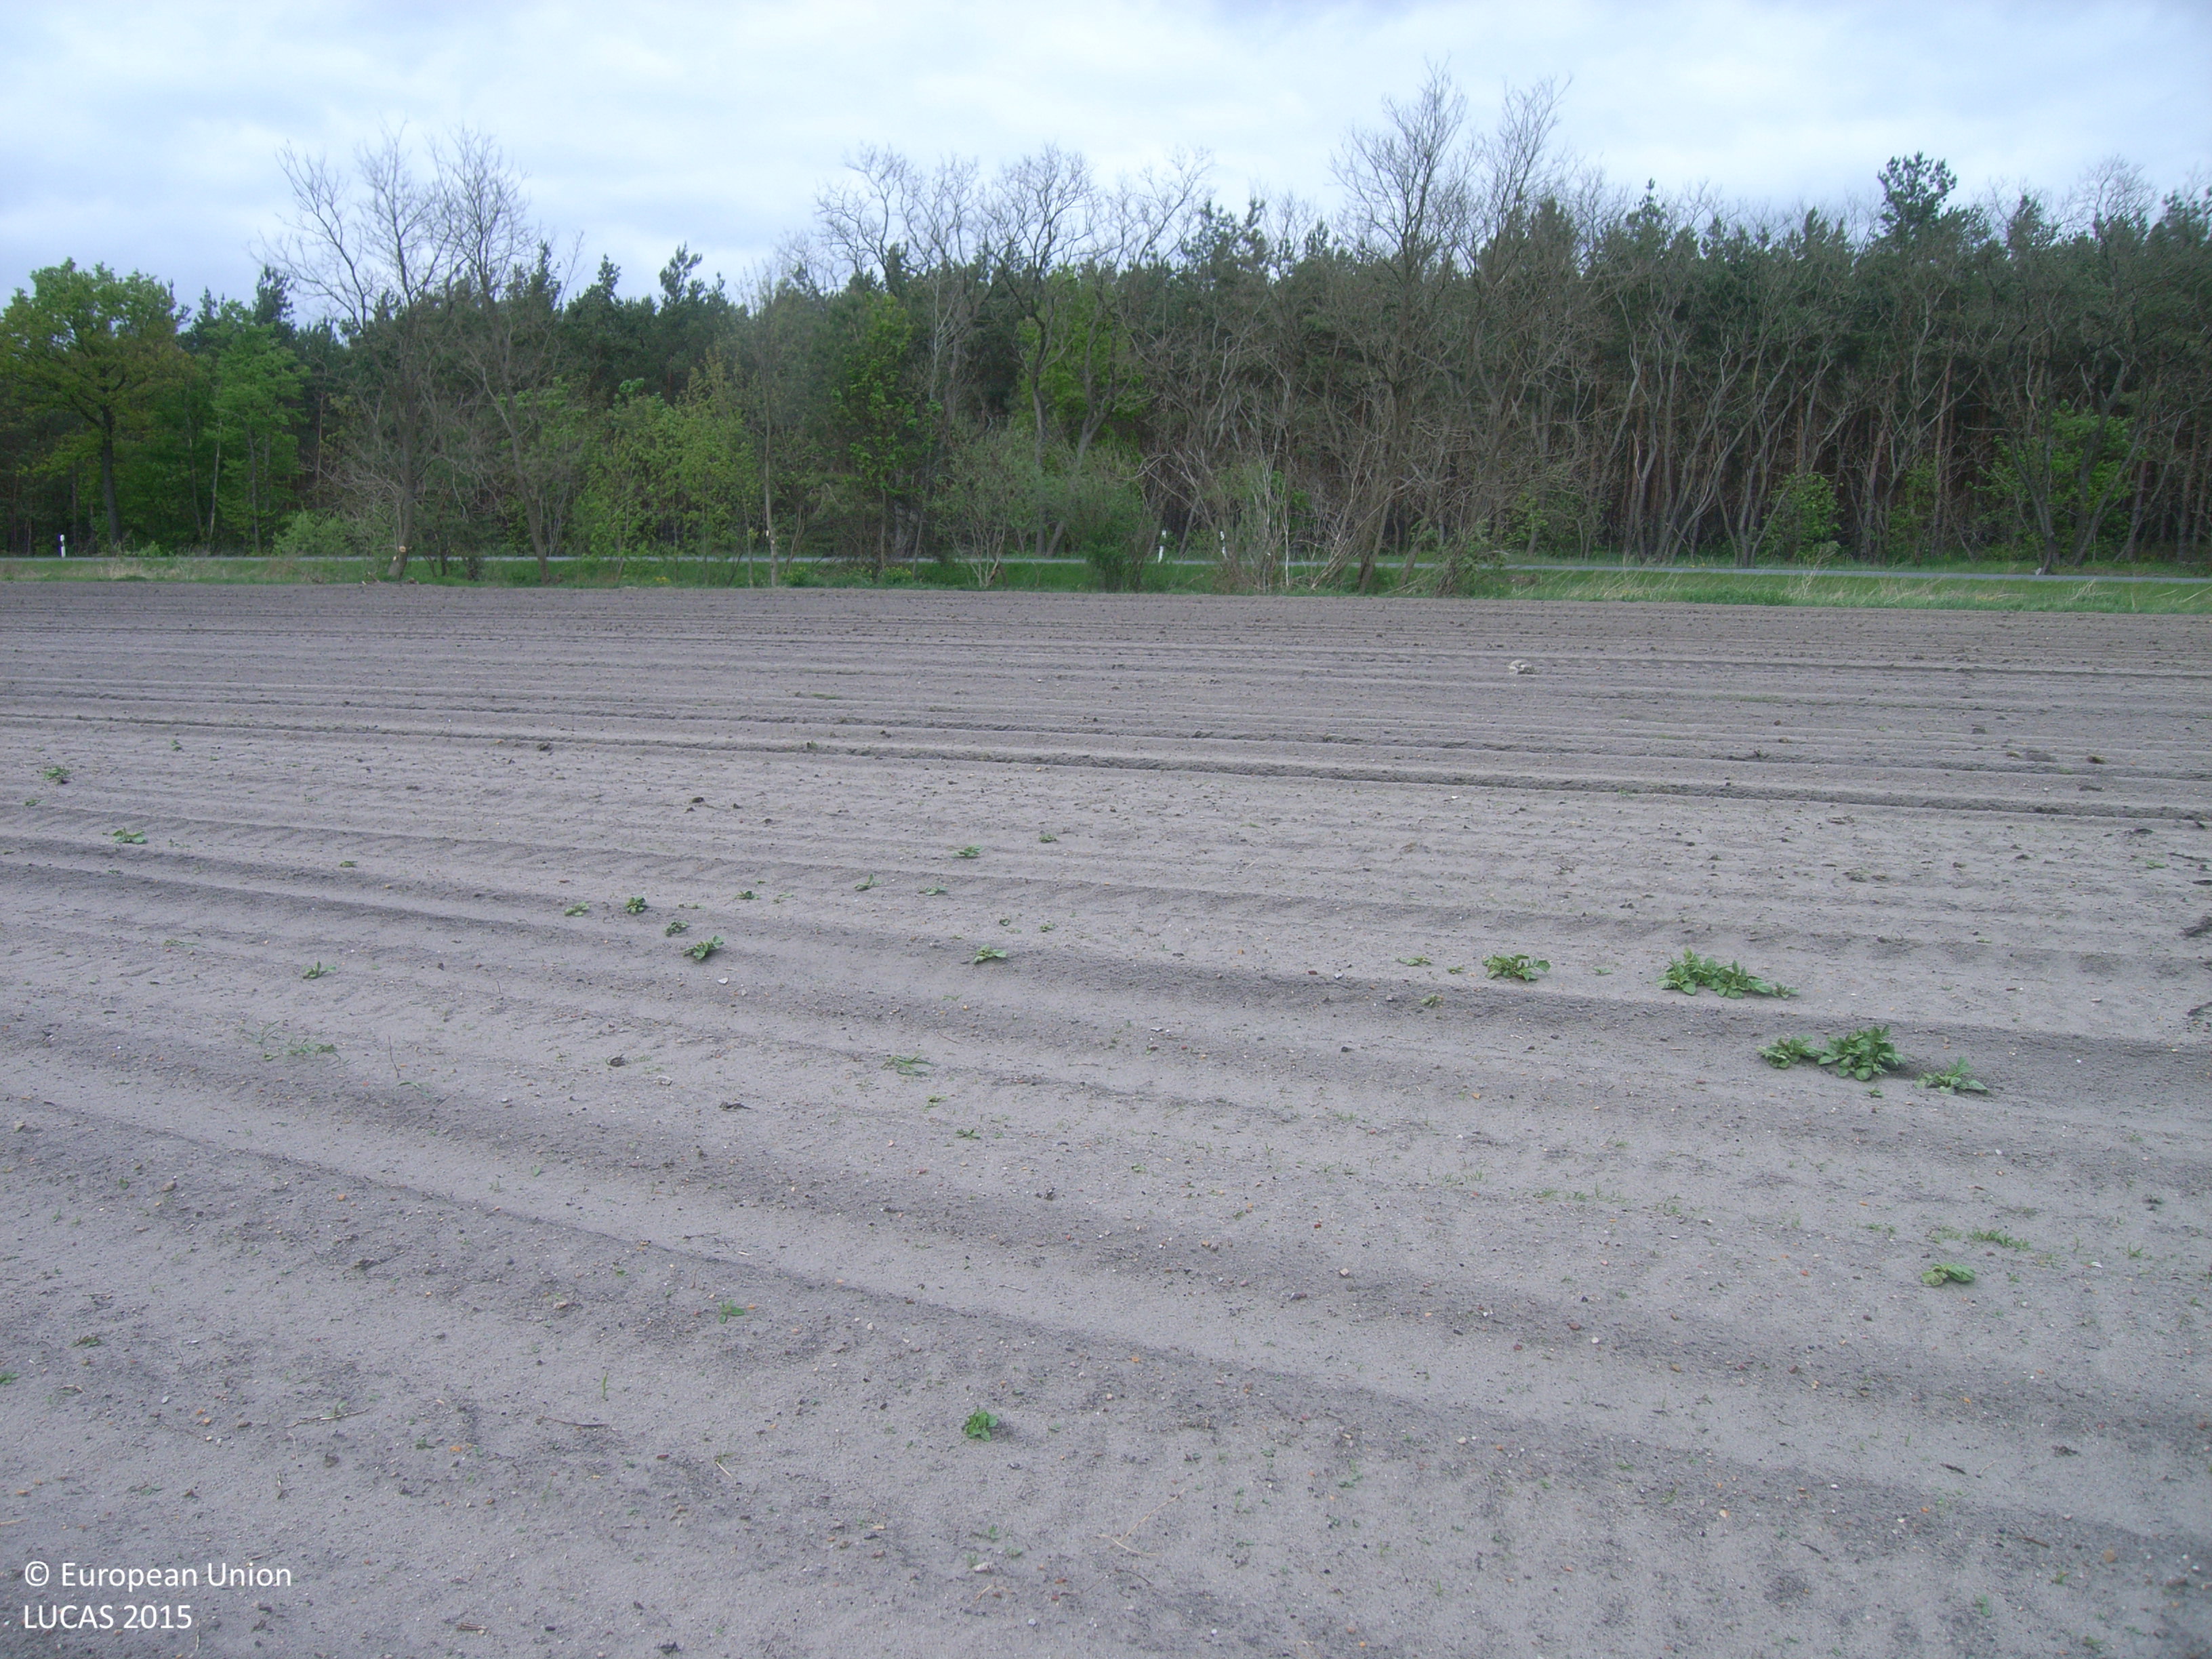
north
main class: Cropland
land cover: Potatoes
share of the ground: < 10 %
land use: Agriculture (excluding fallow land and kitchen gardens)
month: May
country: DE
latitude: 52.0538
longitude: 13.5733
